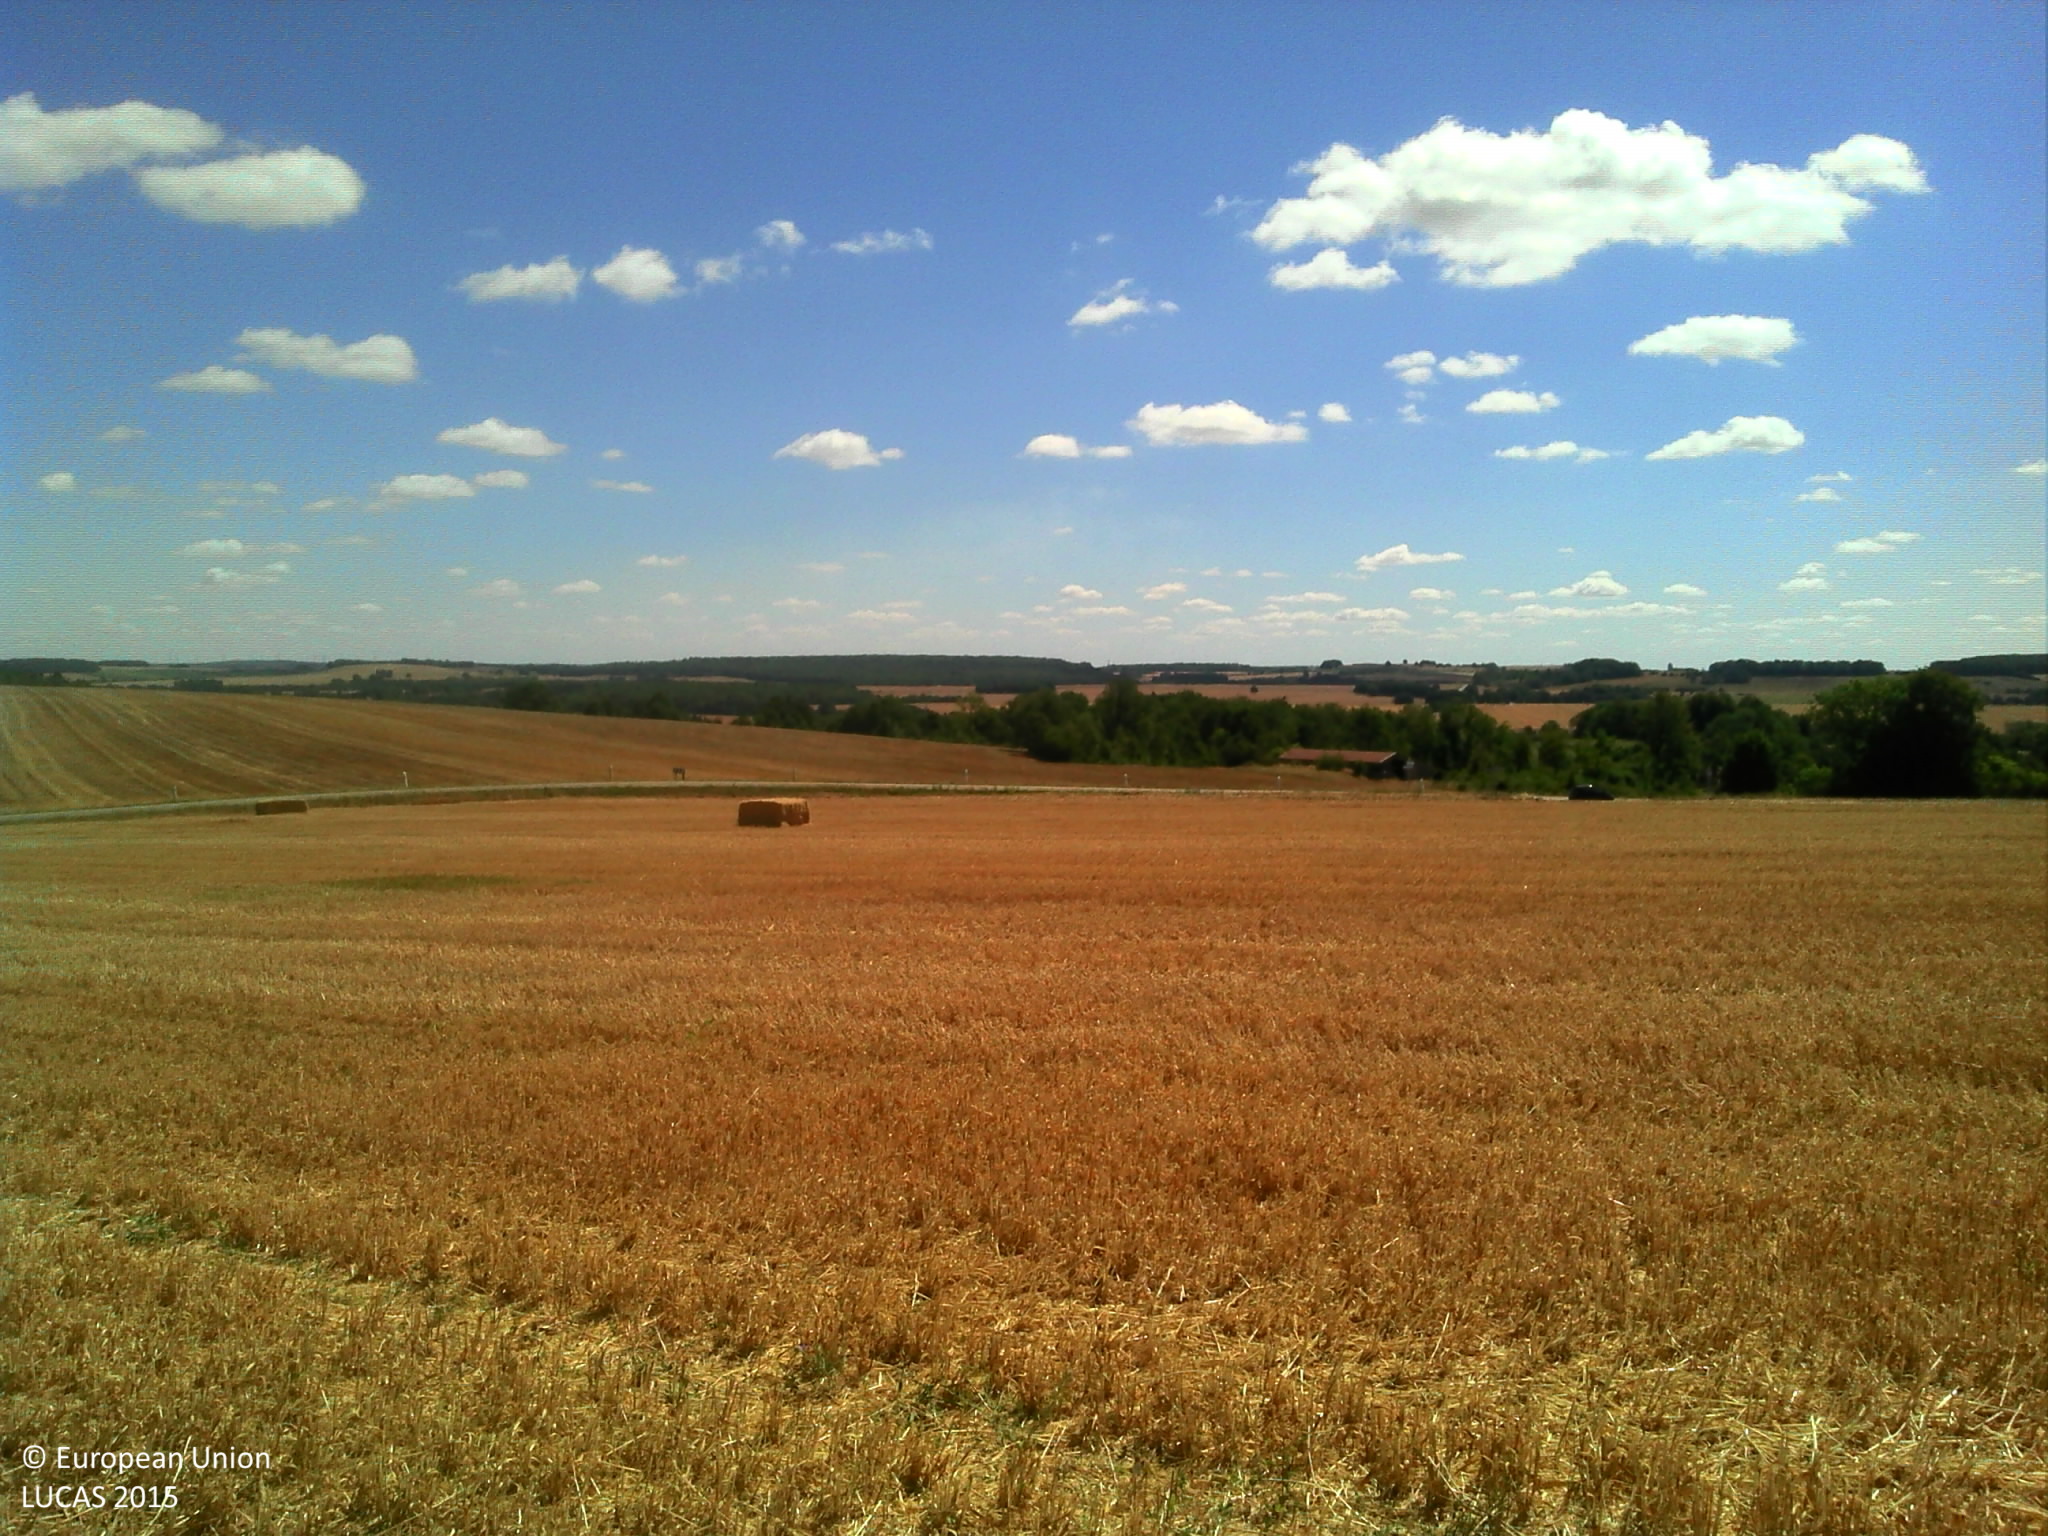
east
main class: Cropland
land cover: Barley
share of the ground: 10 - 25 %
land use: Agriculture (excluding fallow land and kitchen gardens)
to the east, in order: Barley; Common wheat; Grass margins; Paved roads, cycling and walking lanes; Grass margins; Barley
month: July
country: FR
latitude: 47.9194
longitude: 5.1688
